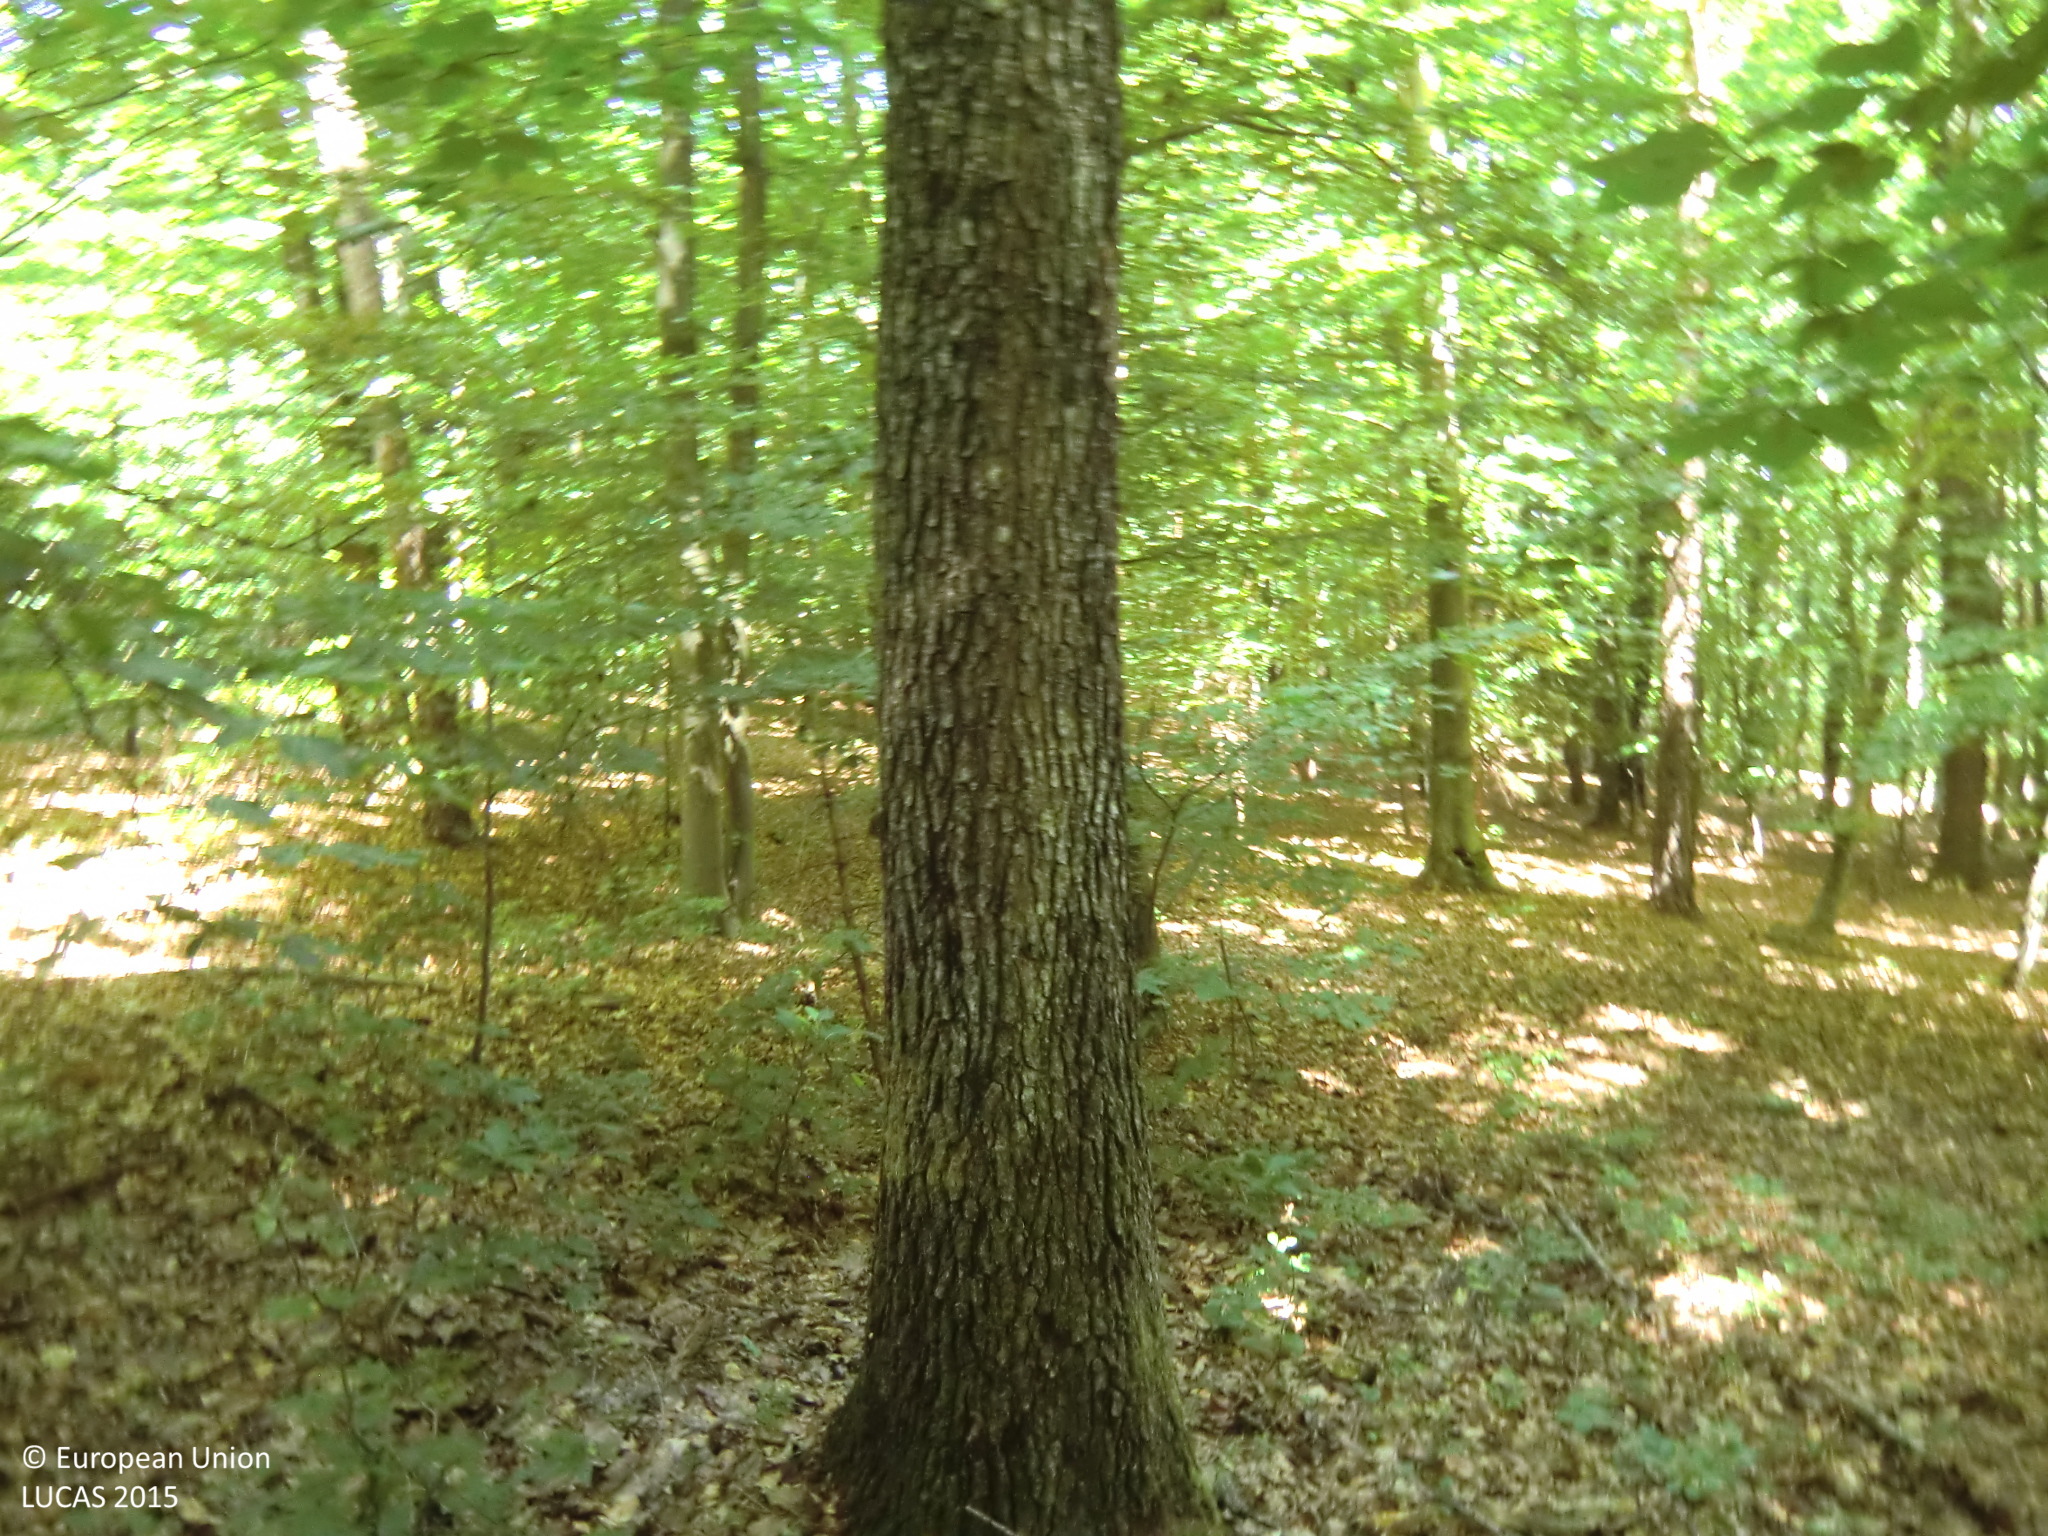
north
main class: Woodland
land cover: Pine dominated mixed woodland
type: hemiboreal forest and nemoral coniferous forest and mixed broadleaved-coniferous forest
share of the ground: > 75 %
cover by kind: broadleaved forest trees 65 %, coniferous forest trees 25 %, unconsolidated bare surface 10 %
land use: Forestry
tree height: > 5 m
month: July
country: AT
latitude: 47.0670
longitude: 15.6756
